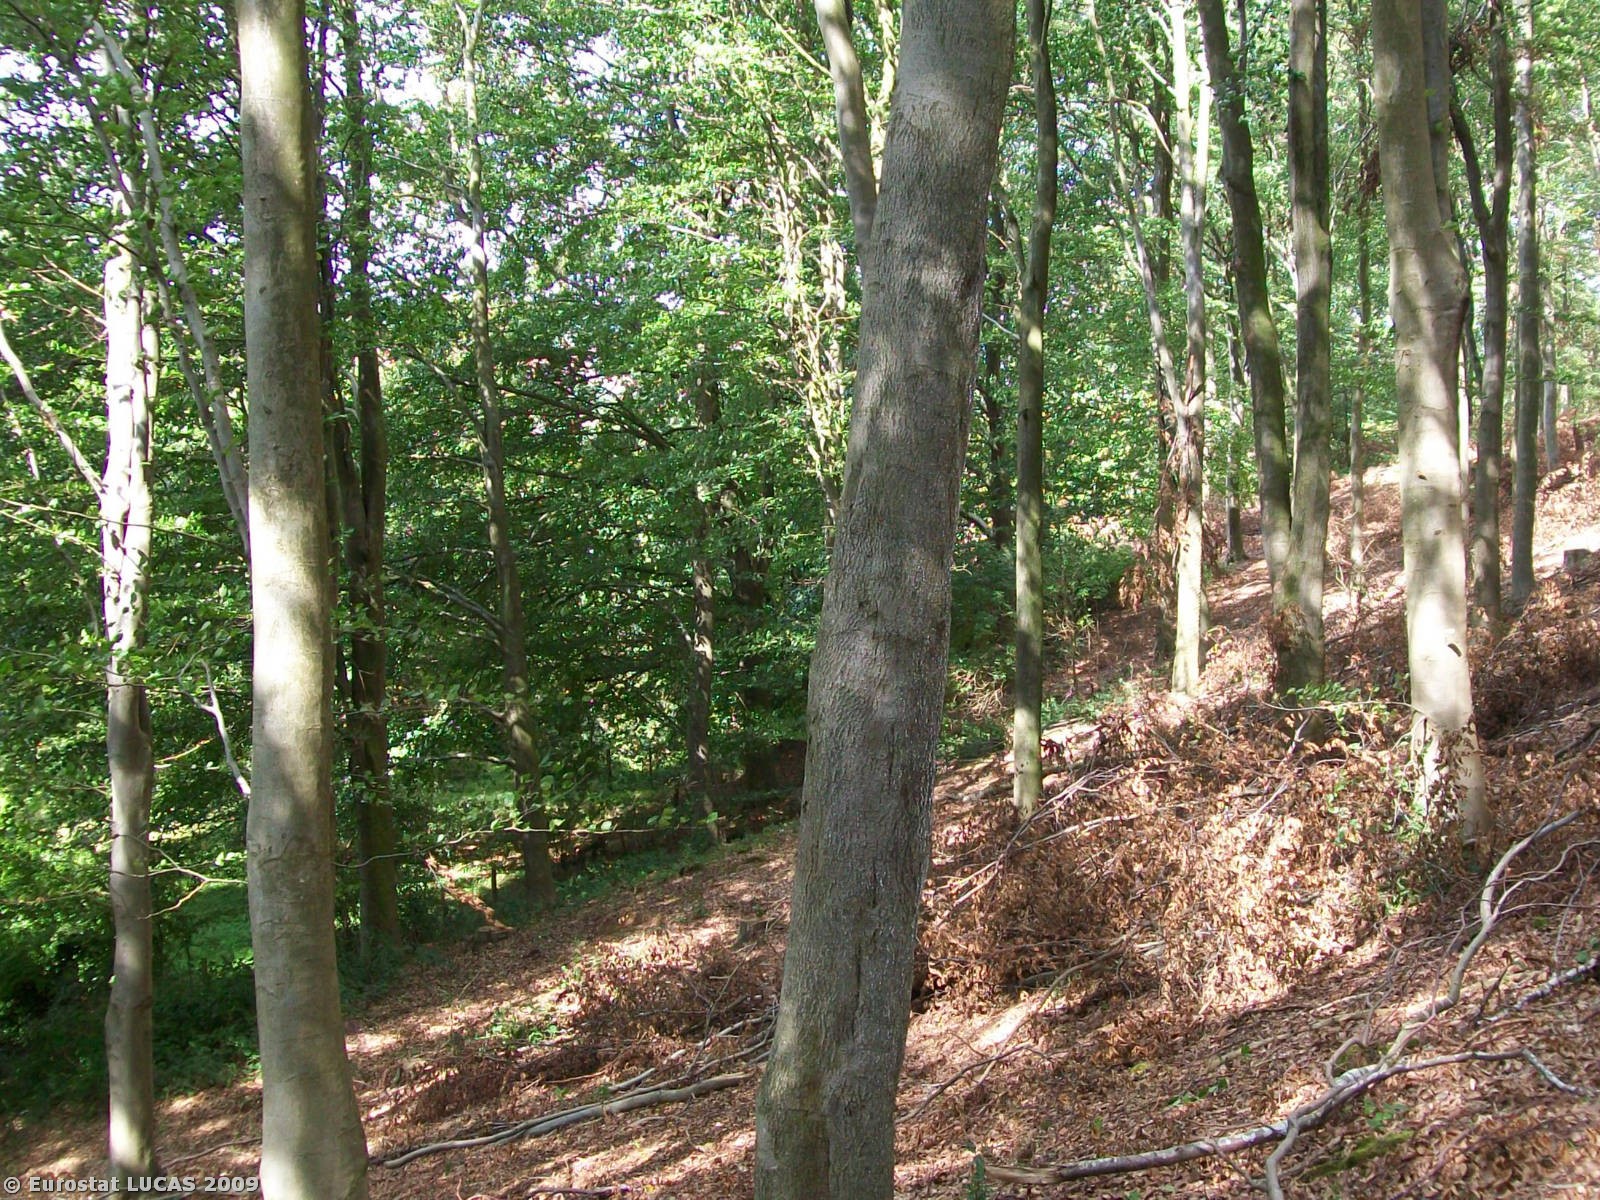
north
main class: Woodland
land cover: Broadleaved woodland
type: mesophytic deciduous forest
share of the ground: > 75 %
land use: Forestry
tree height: > 5 m
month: August
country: GB
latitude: 51.9794
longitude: -2.3963
